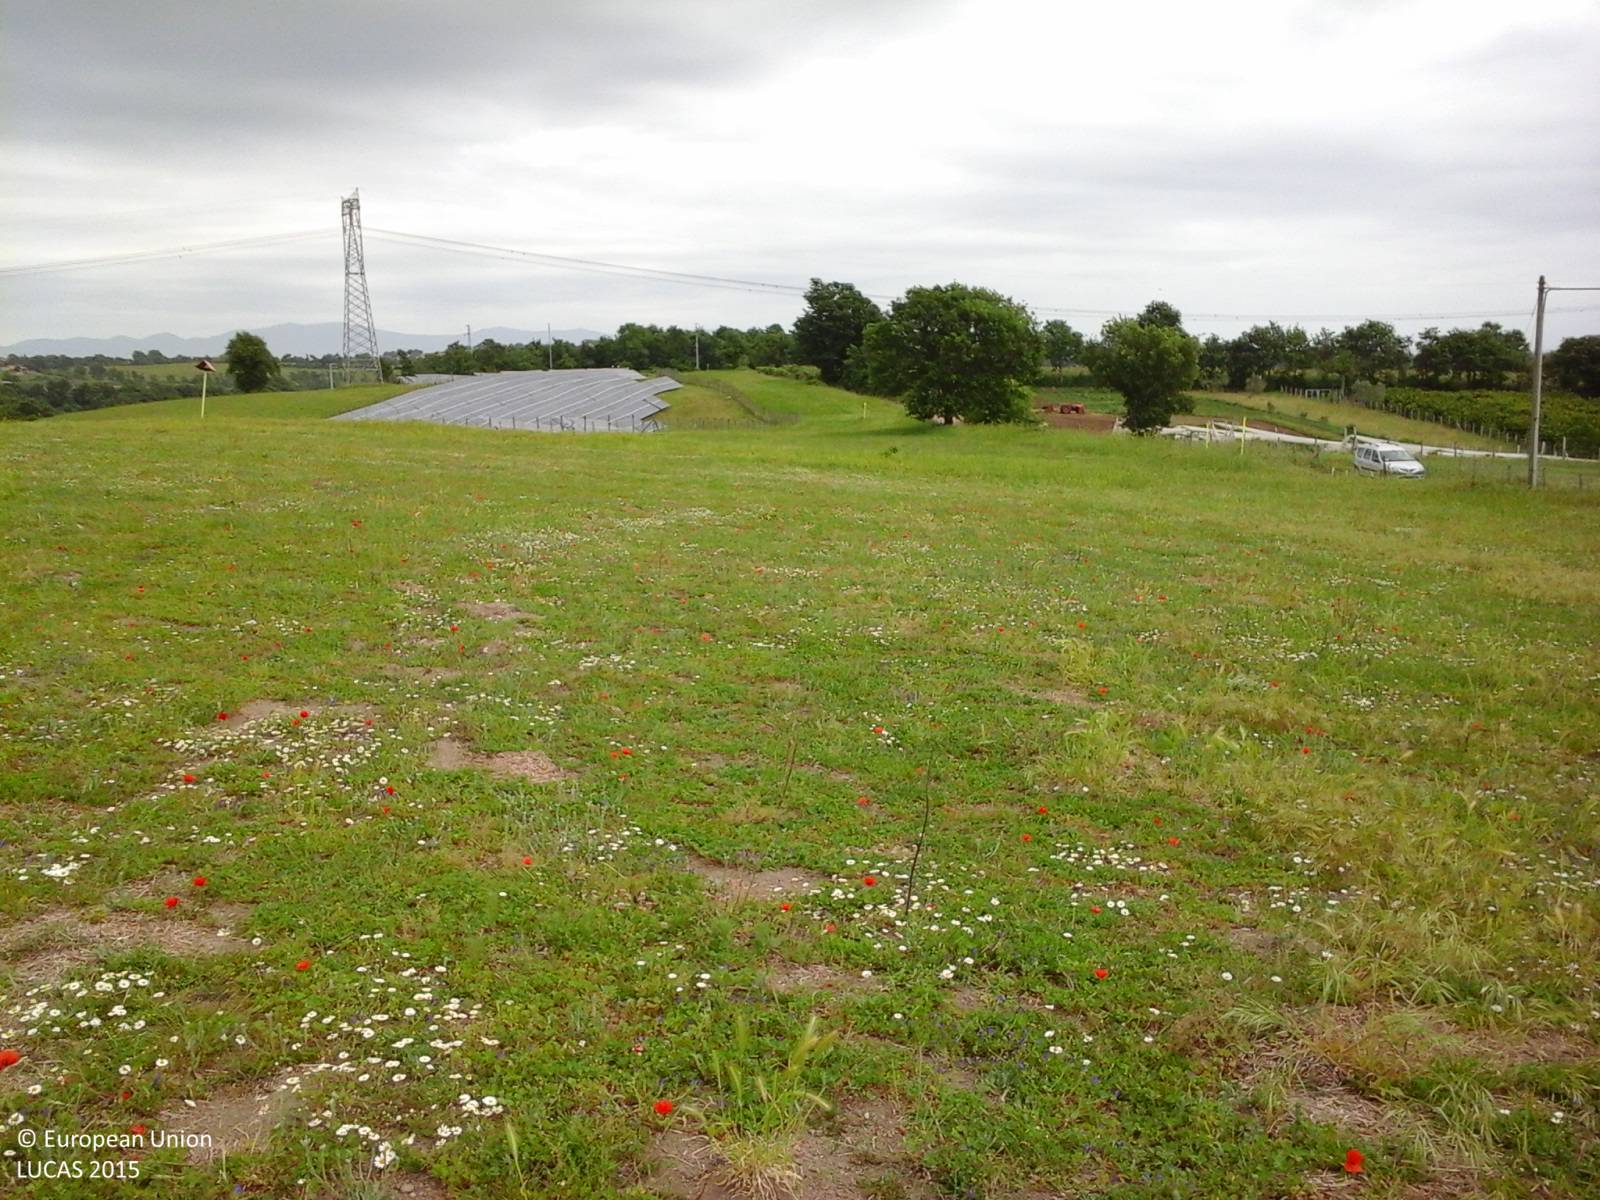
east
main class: Cropland
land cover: Lucerne
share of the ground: > 75 %
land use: Agriculture (excluding fallow land and kitchen gardens)
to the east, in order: Lucerne; Fences; Grass margins; Tracks; Single bushes/trees; Fences; Grassland without tree/shrub cover; Other fruit trees and berries; Grassland without tree/shrub cover; Tomatoes
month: May
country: IT
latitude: 42.5600
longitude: 12.1002
